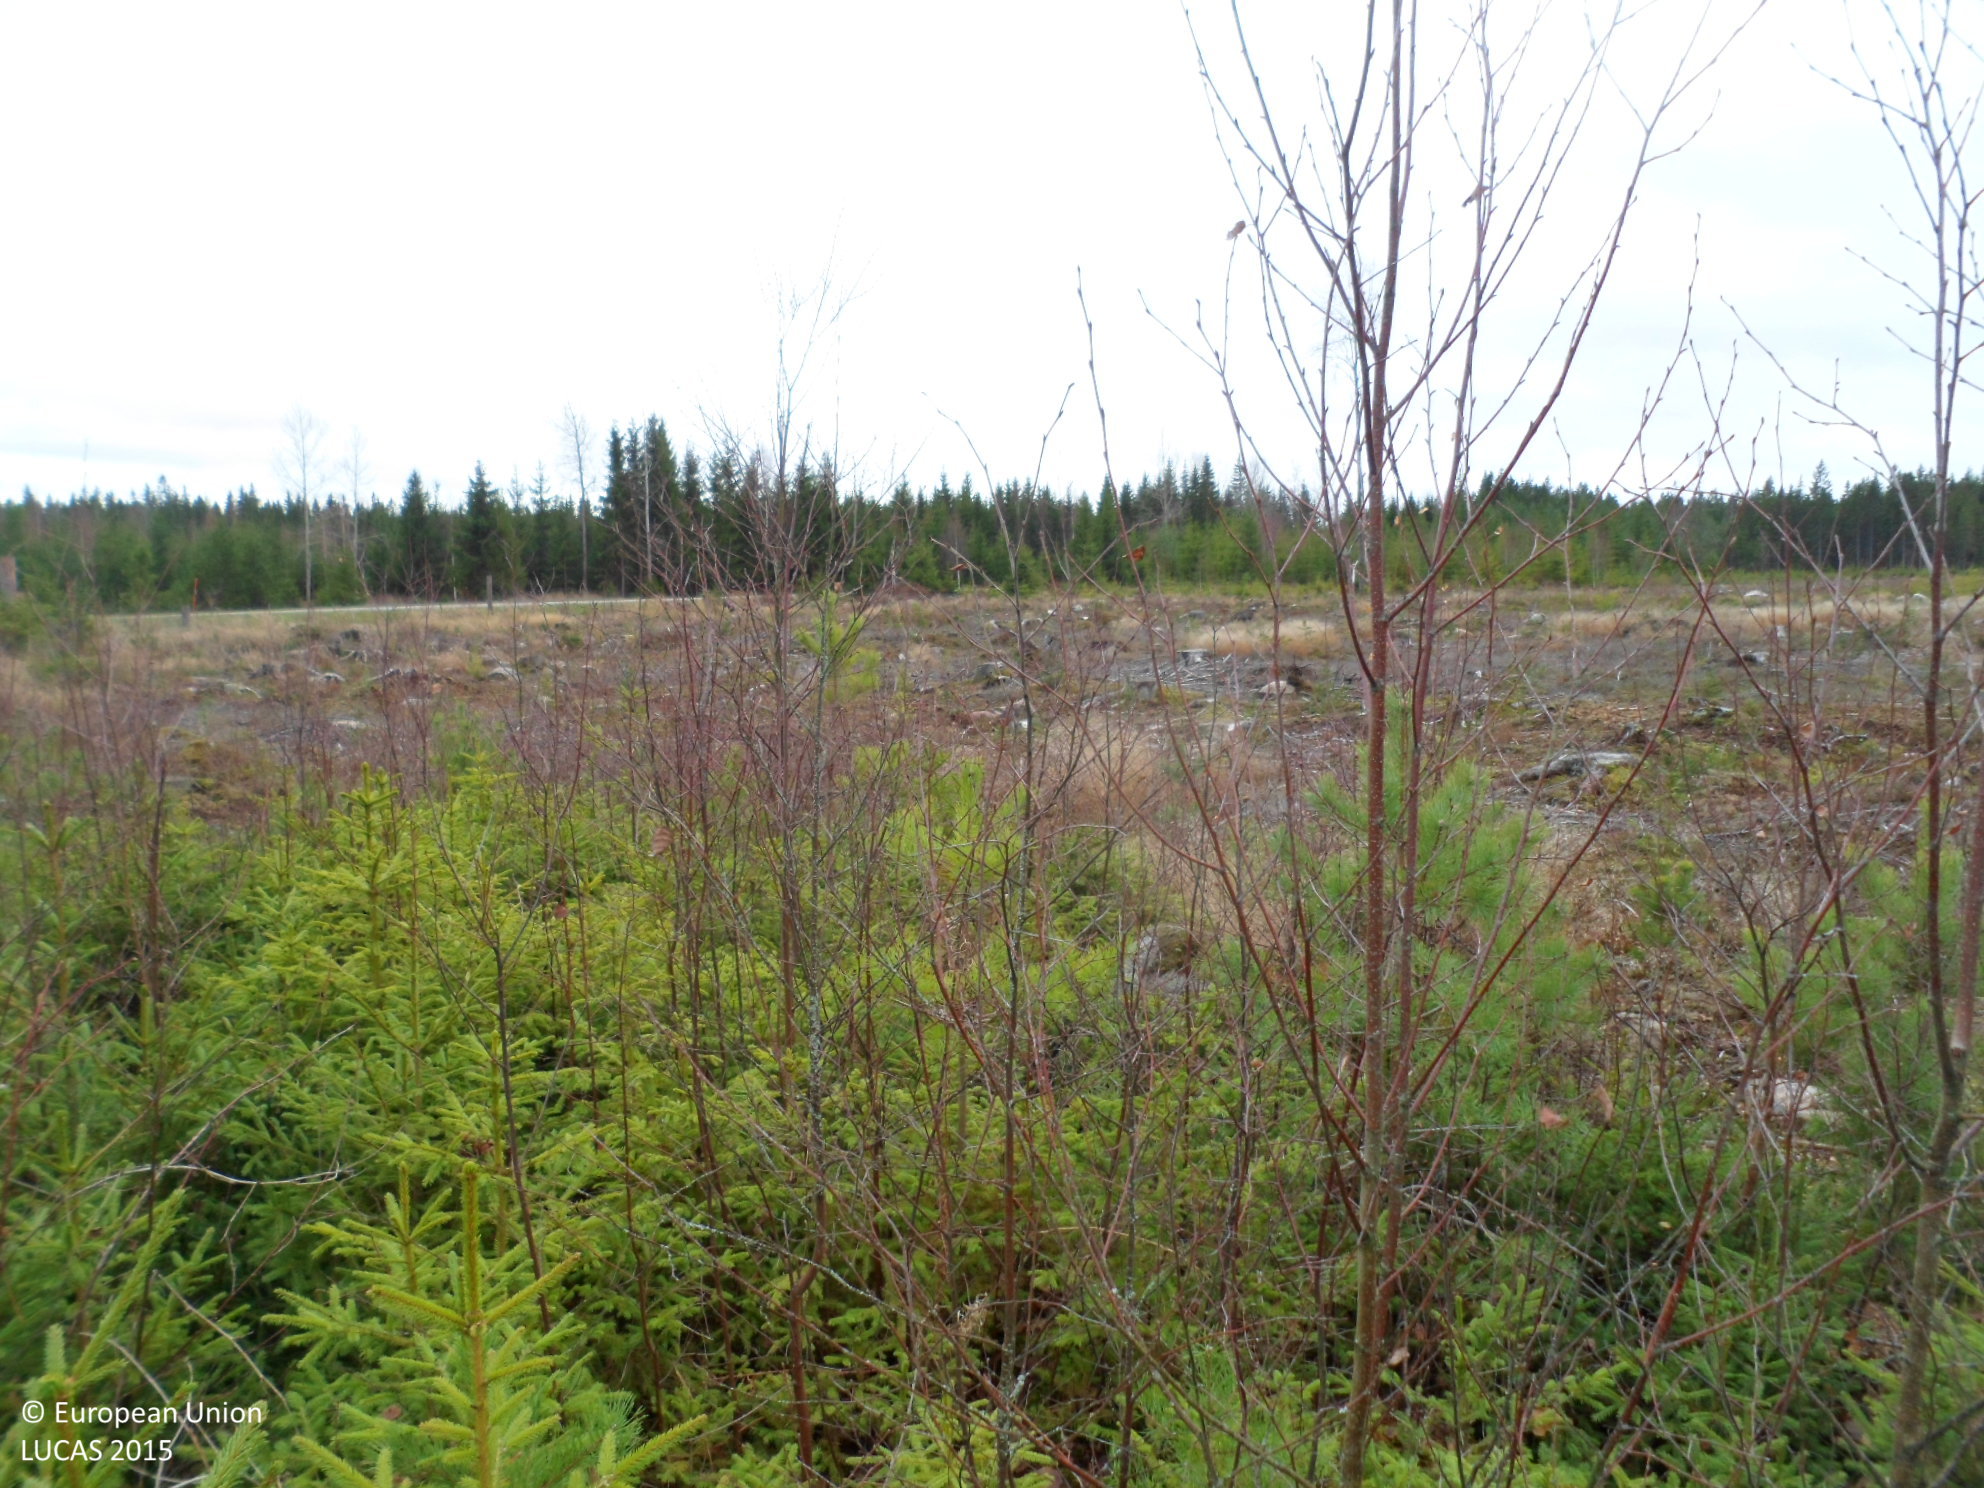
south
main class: Woodland
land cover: Spruce dominated mixed woodland
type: boreal forest
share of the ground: 50 - 75 %
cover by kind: coniferous forest trees 50 %, broadleaved forest trees 25 %, shrubs 10 %, lichens and mosses 10 %, herbaceous plants 5 %
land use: Forestry
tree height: < 5 m
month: November
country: SE
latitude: 56.7895
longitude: 15.9418
